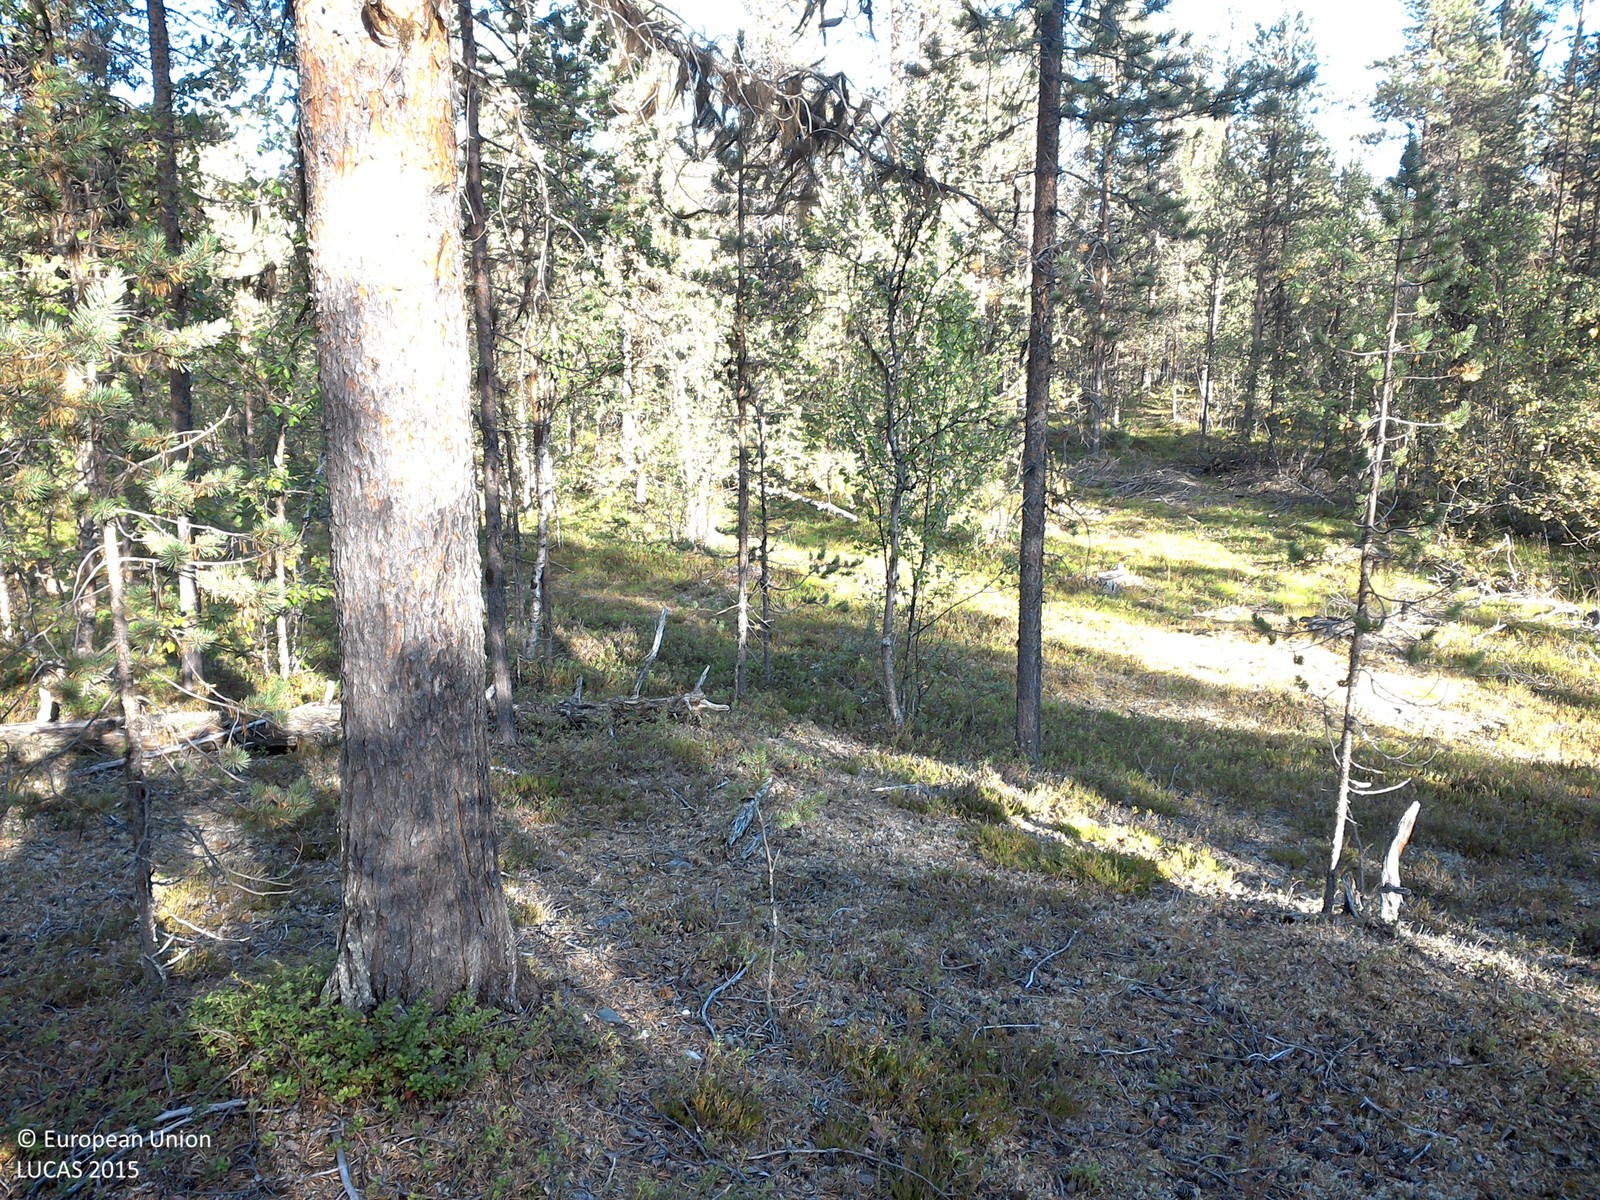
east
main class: Woodland
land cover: Pine dominated mixed woodland
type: boreal forest
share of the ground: 25 - 50 %
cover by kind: shrubs 35 %, lichens and mosses 30 %, coniferous forest trees 25 %, broadleaved forest trees 10 %
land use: Forestry
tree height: > 5 m
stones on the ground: < 10 %
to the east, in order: Pine dominated mixed woodland; Peatbogs; Pine dominated mixed woodland; Tracks; Pine dominated mixed woodland
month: August
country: SE
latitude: 68.1245
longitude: 23.0615
